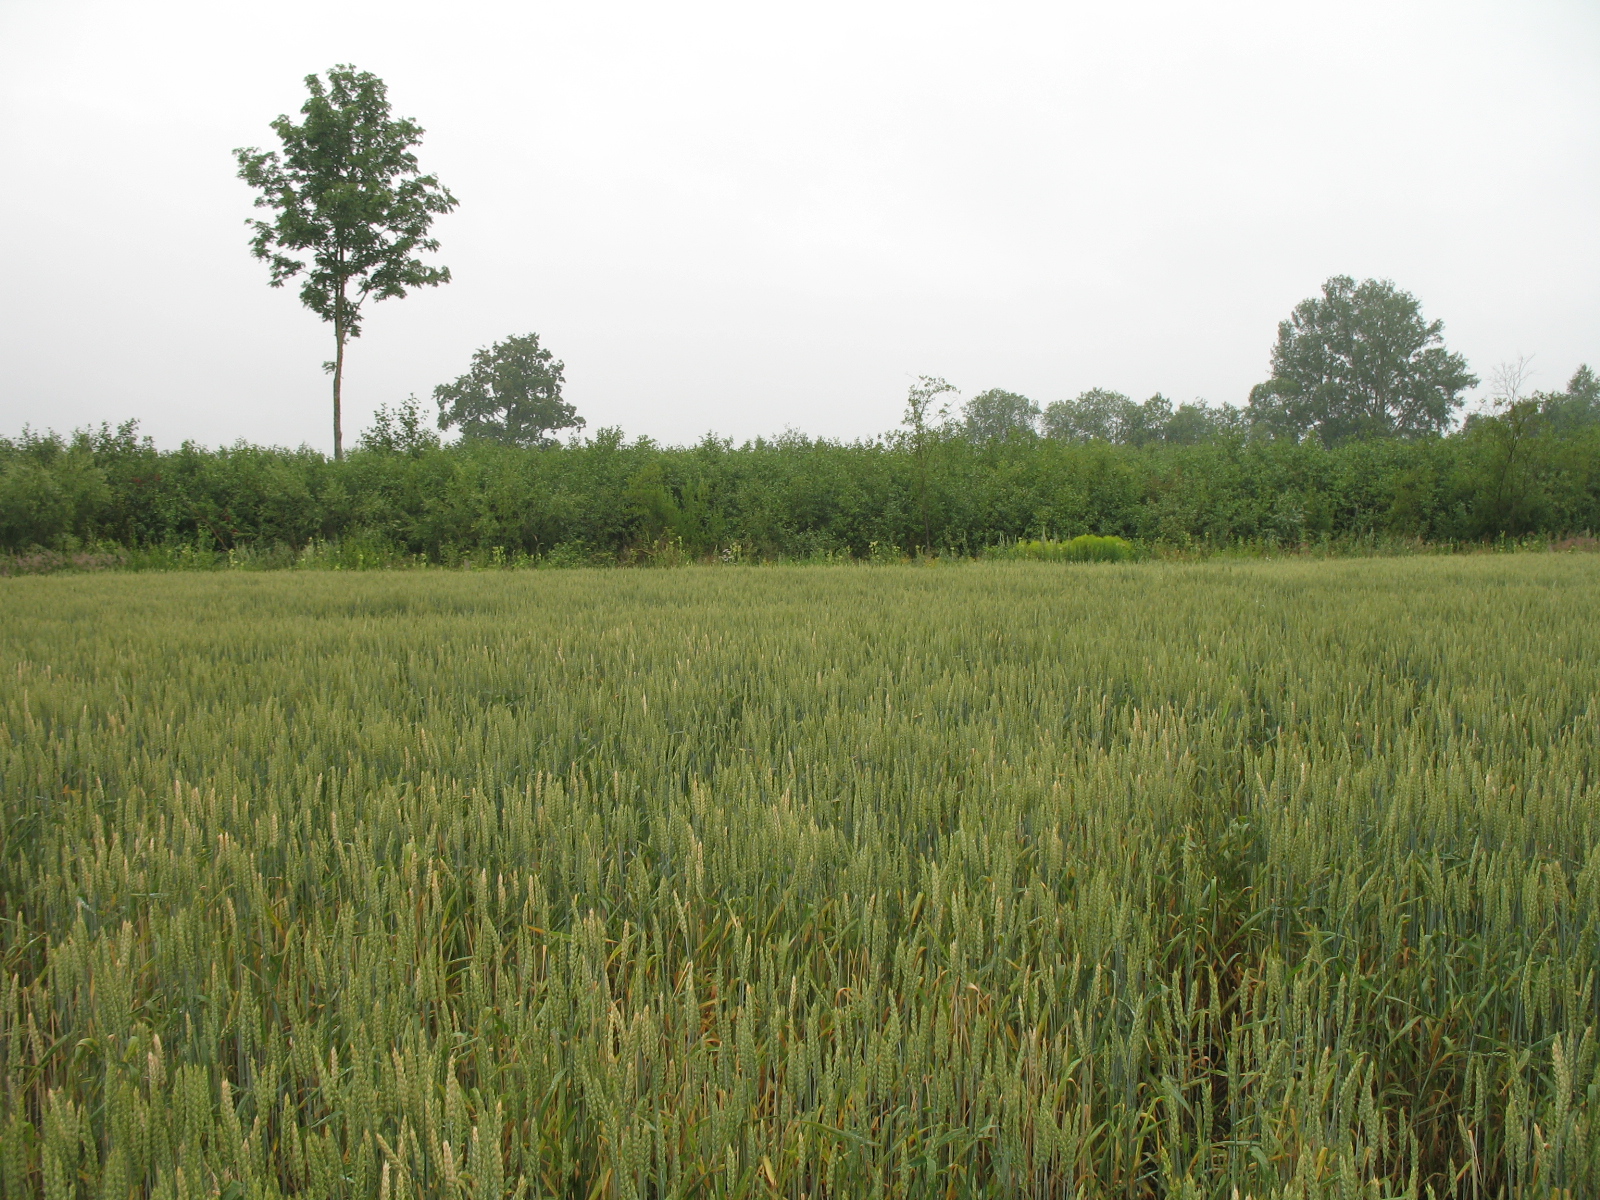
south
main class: Cropland
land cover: Common wheat
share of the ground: > 75 %
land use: Agriculture (excluding fallow land and kitchen gardens)
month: July
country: LV
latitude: 56.3600
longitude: 25.0157
